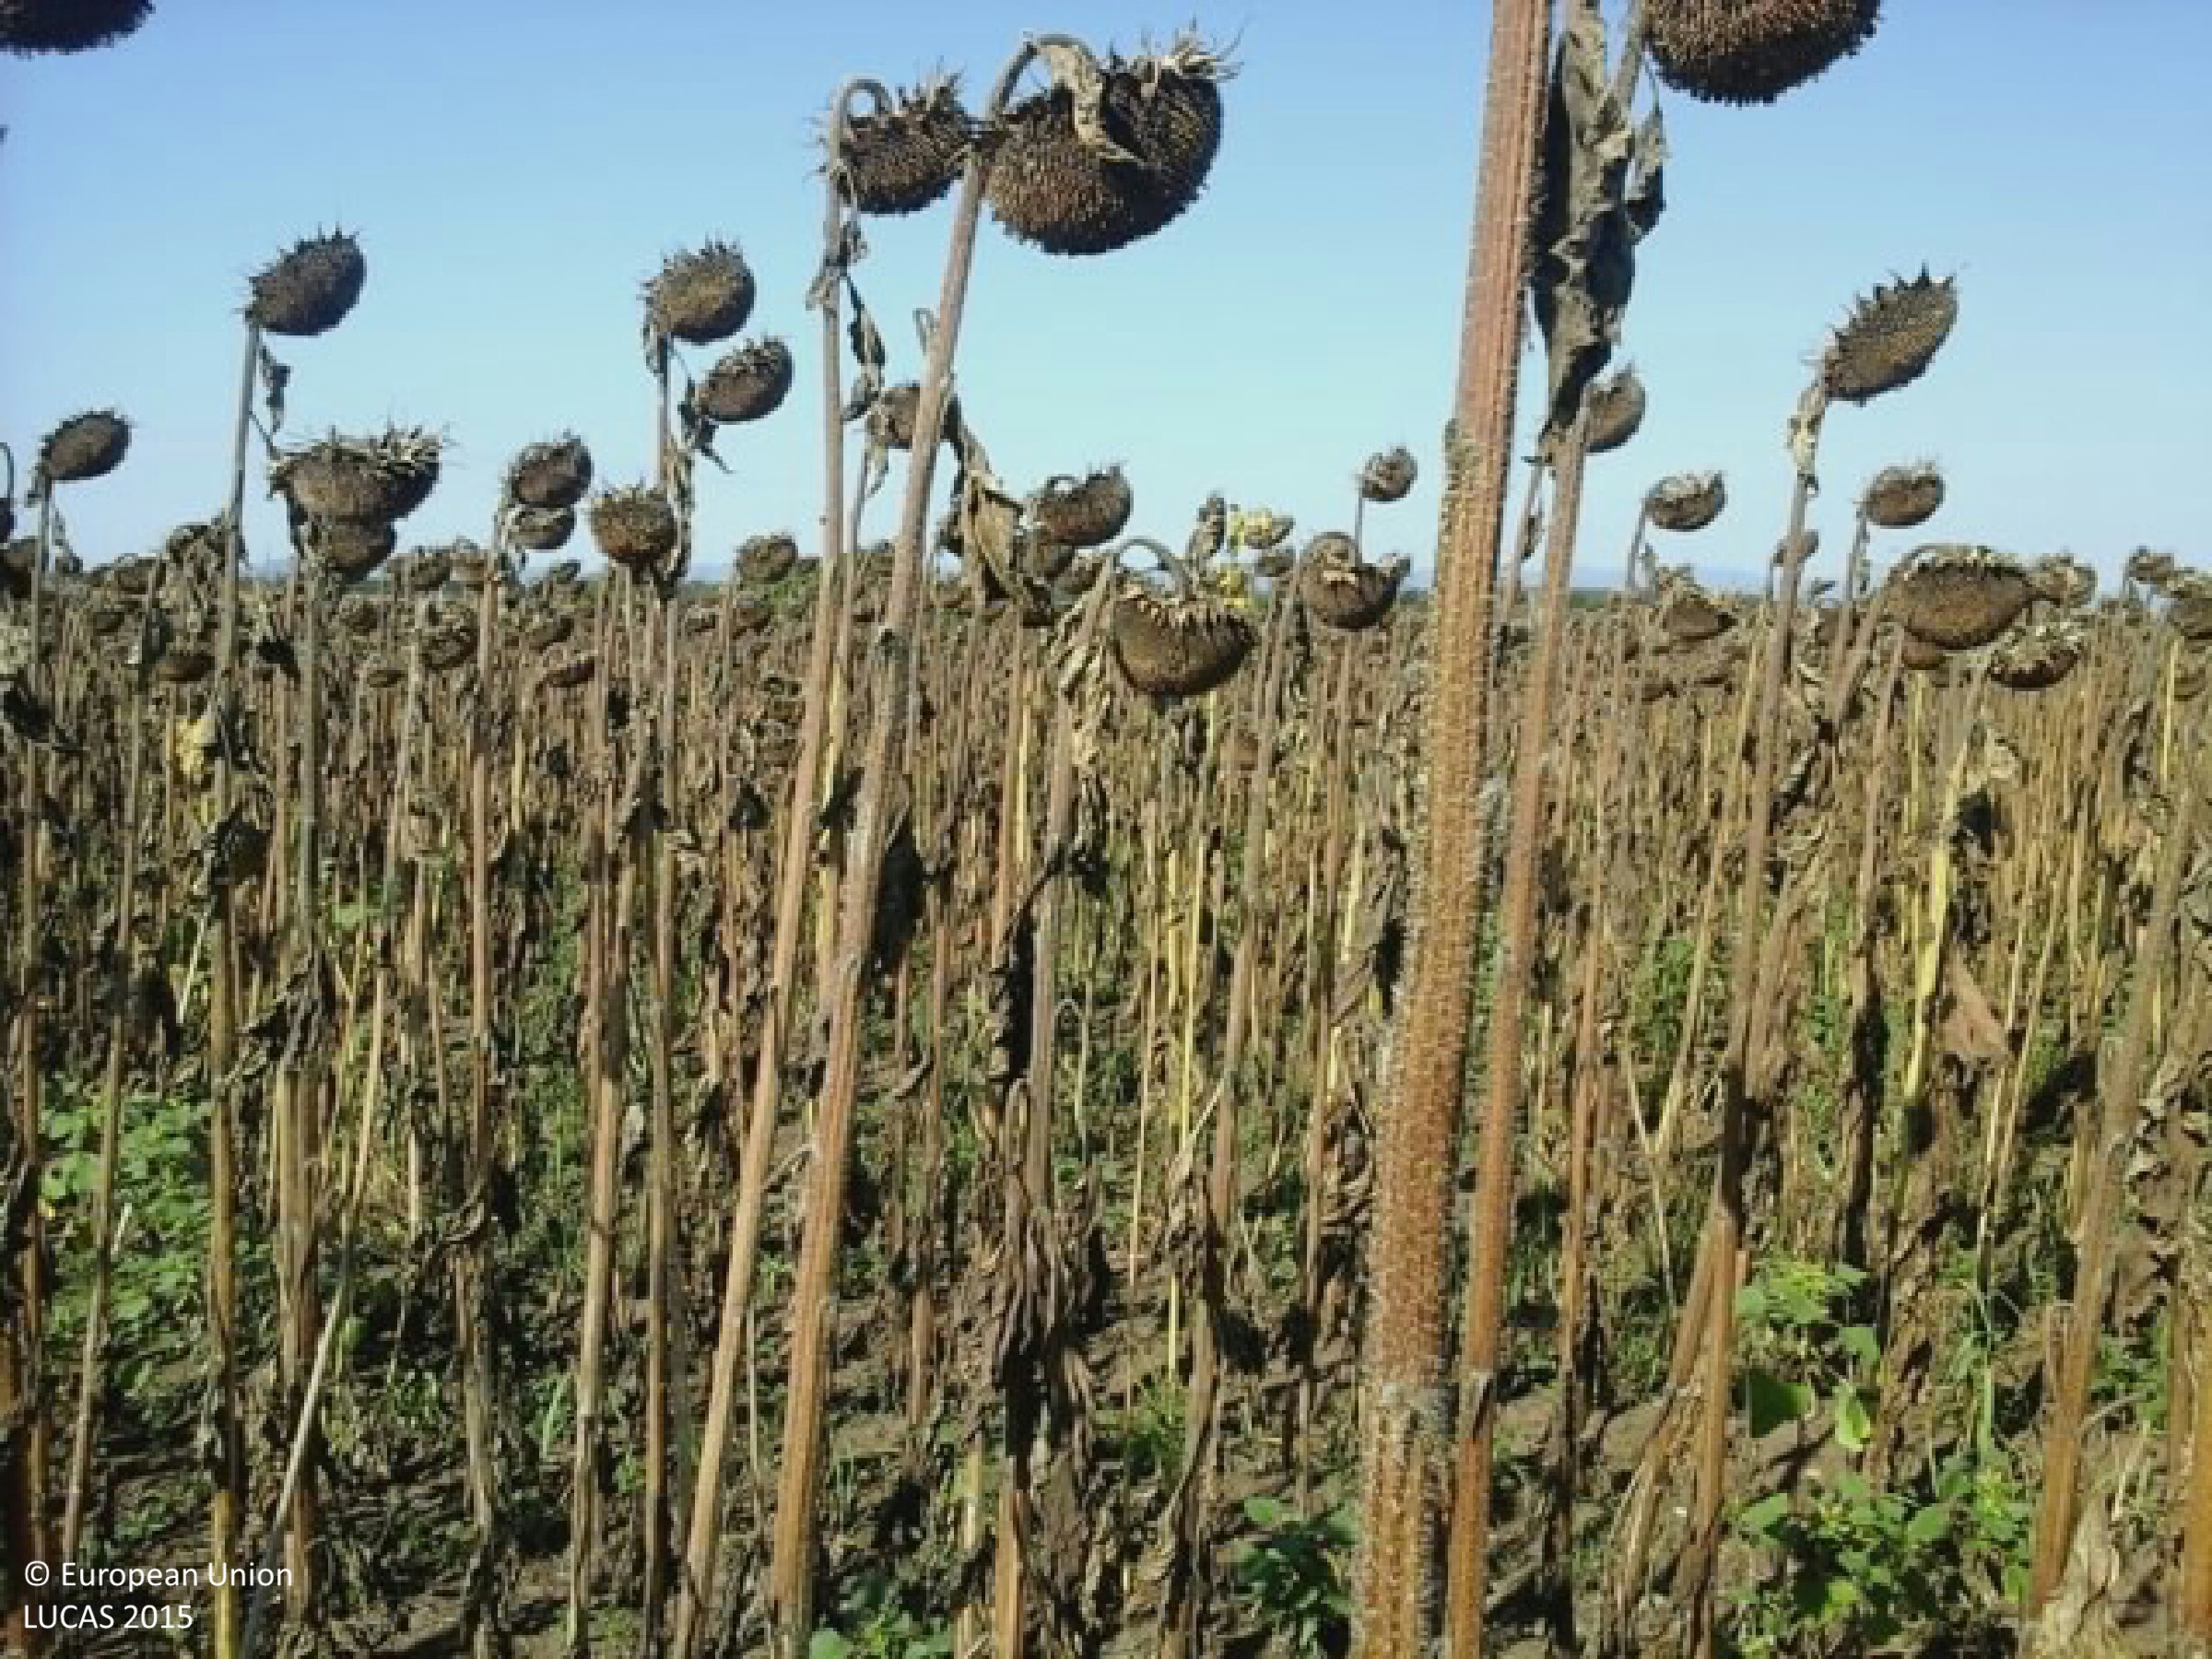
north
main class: Cropland
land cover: Sunflower
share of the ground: > 75 %
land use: Agriculture (excluding fallow land and kitchen gardens)
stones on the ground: < 10 %
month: September
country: HU
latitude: 47.6426
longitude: 19.7816
